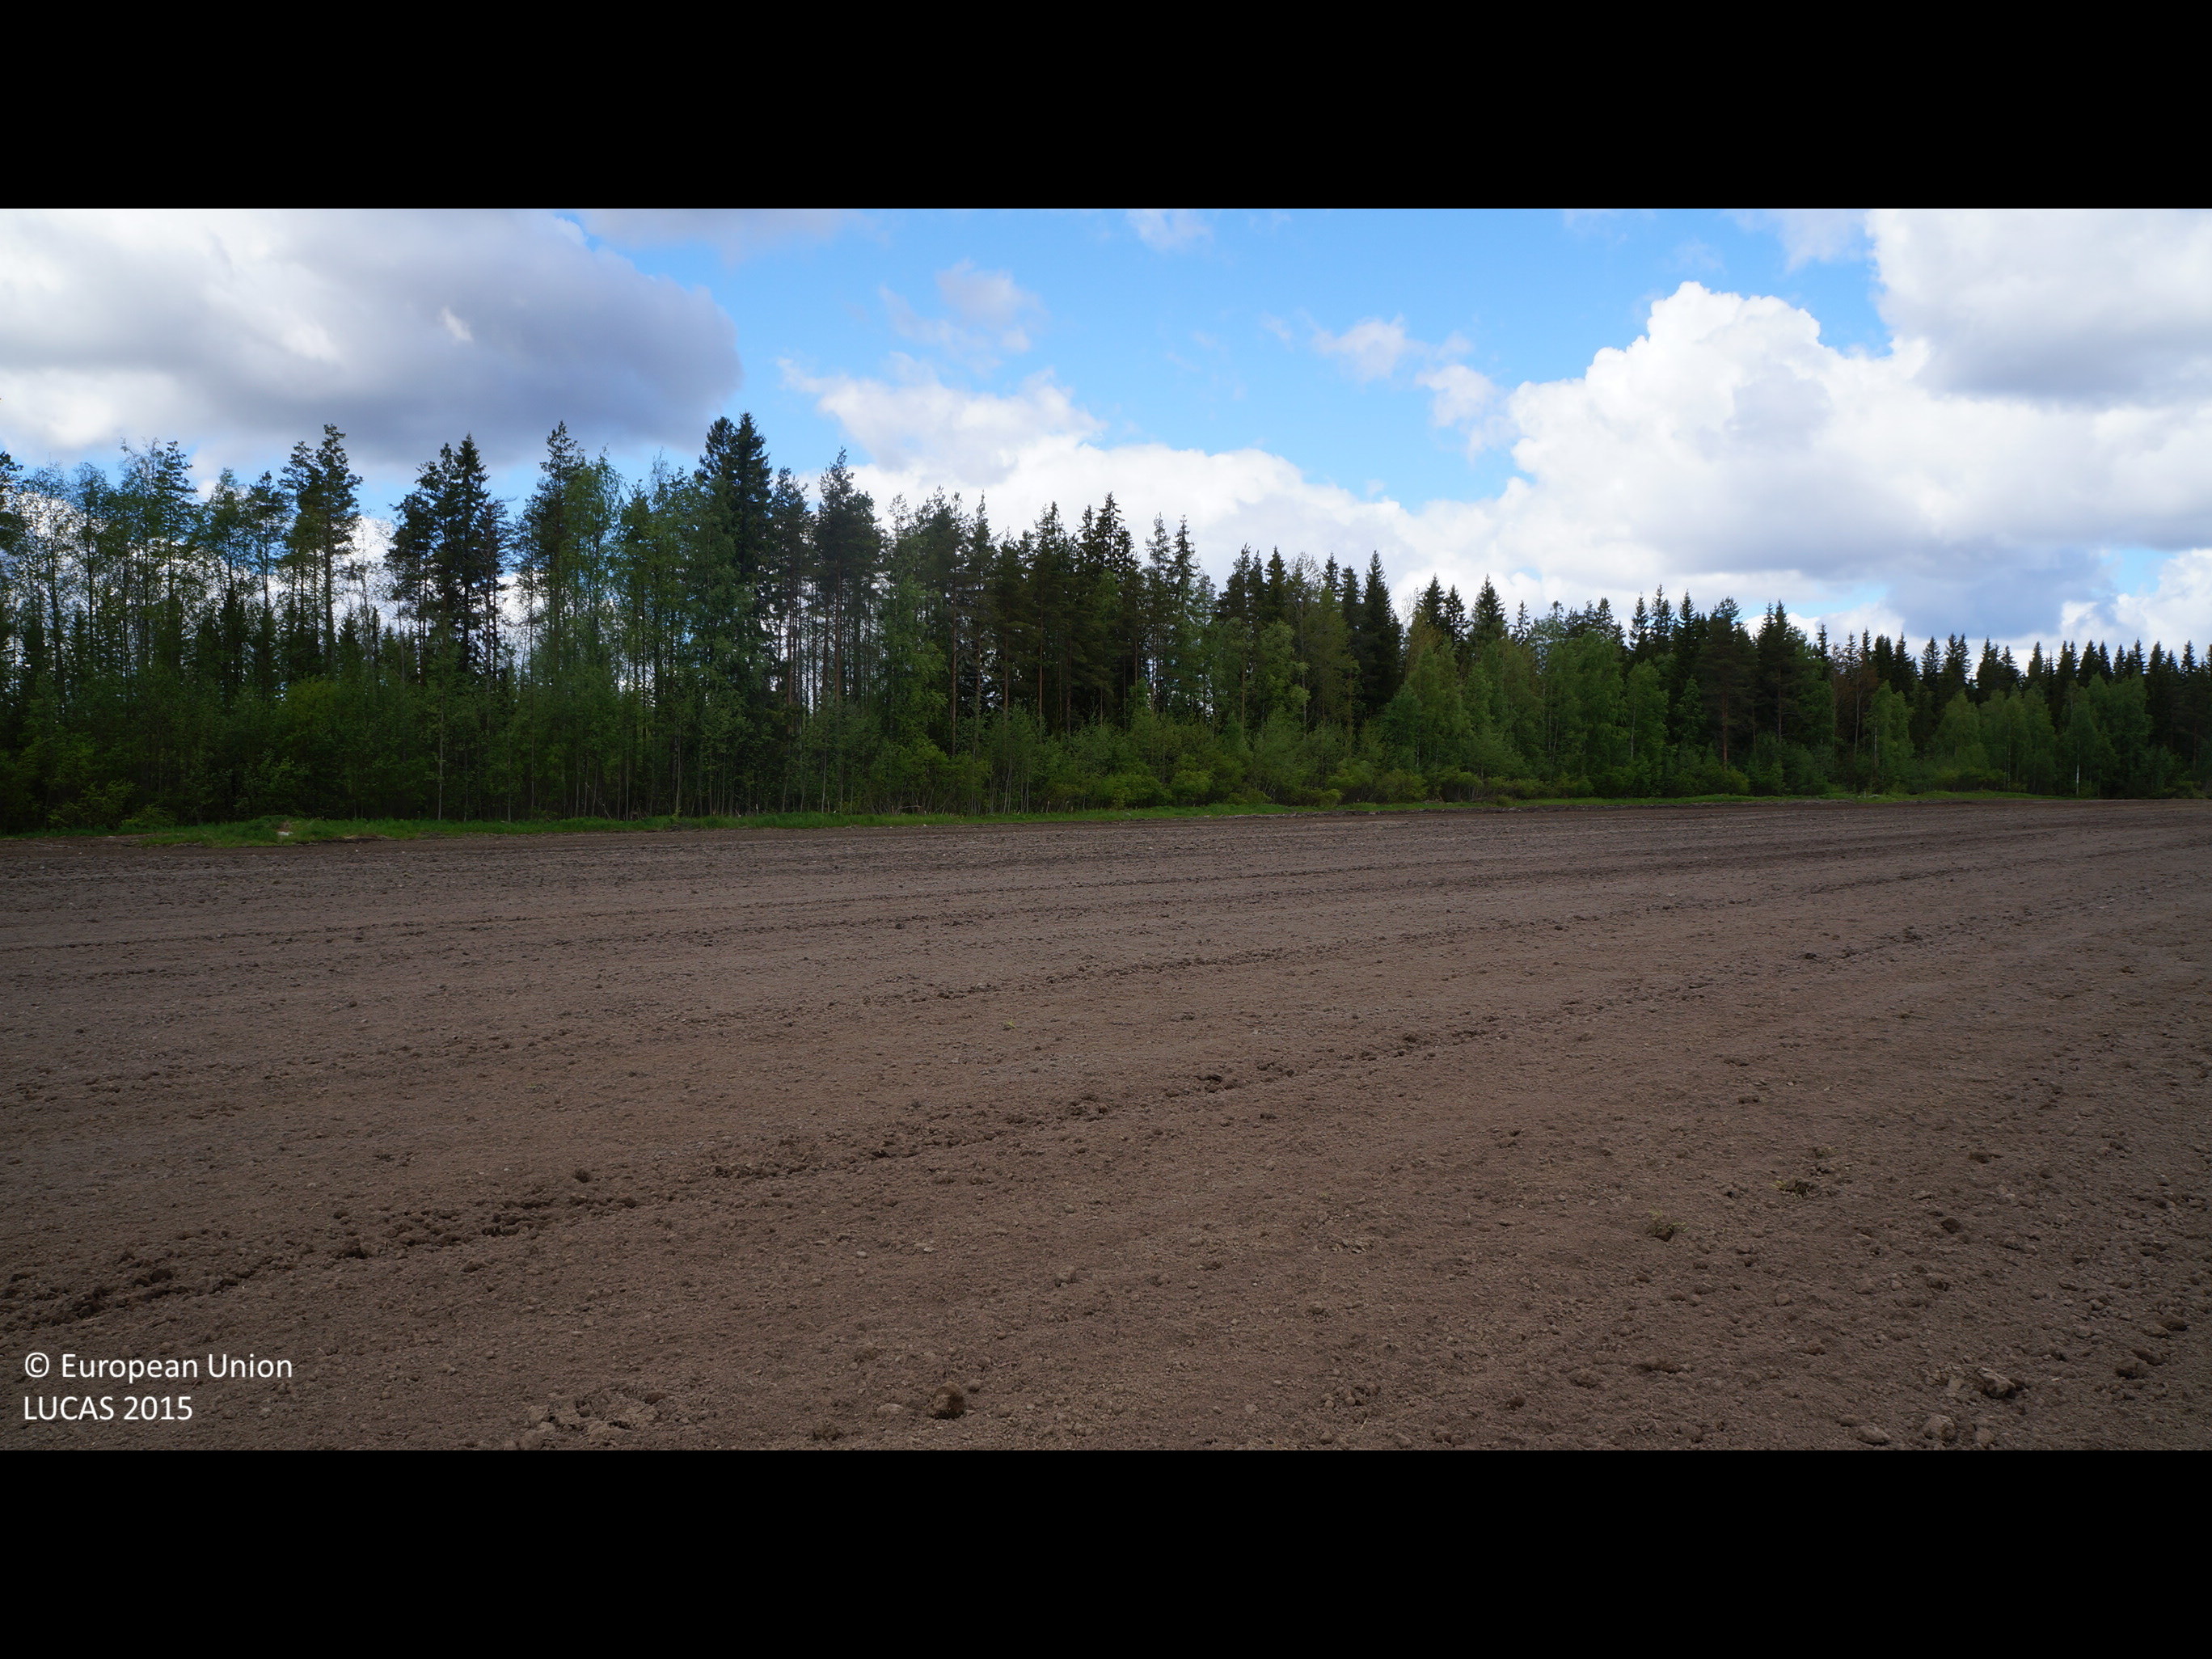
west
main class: Cropland
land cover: Barley
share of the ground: < 10 %
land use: Agriculture (excluding fallow land and kitchen gardens)
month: June
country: FI
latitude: 63.7129
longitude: 24.2603
